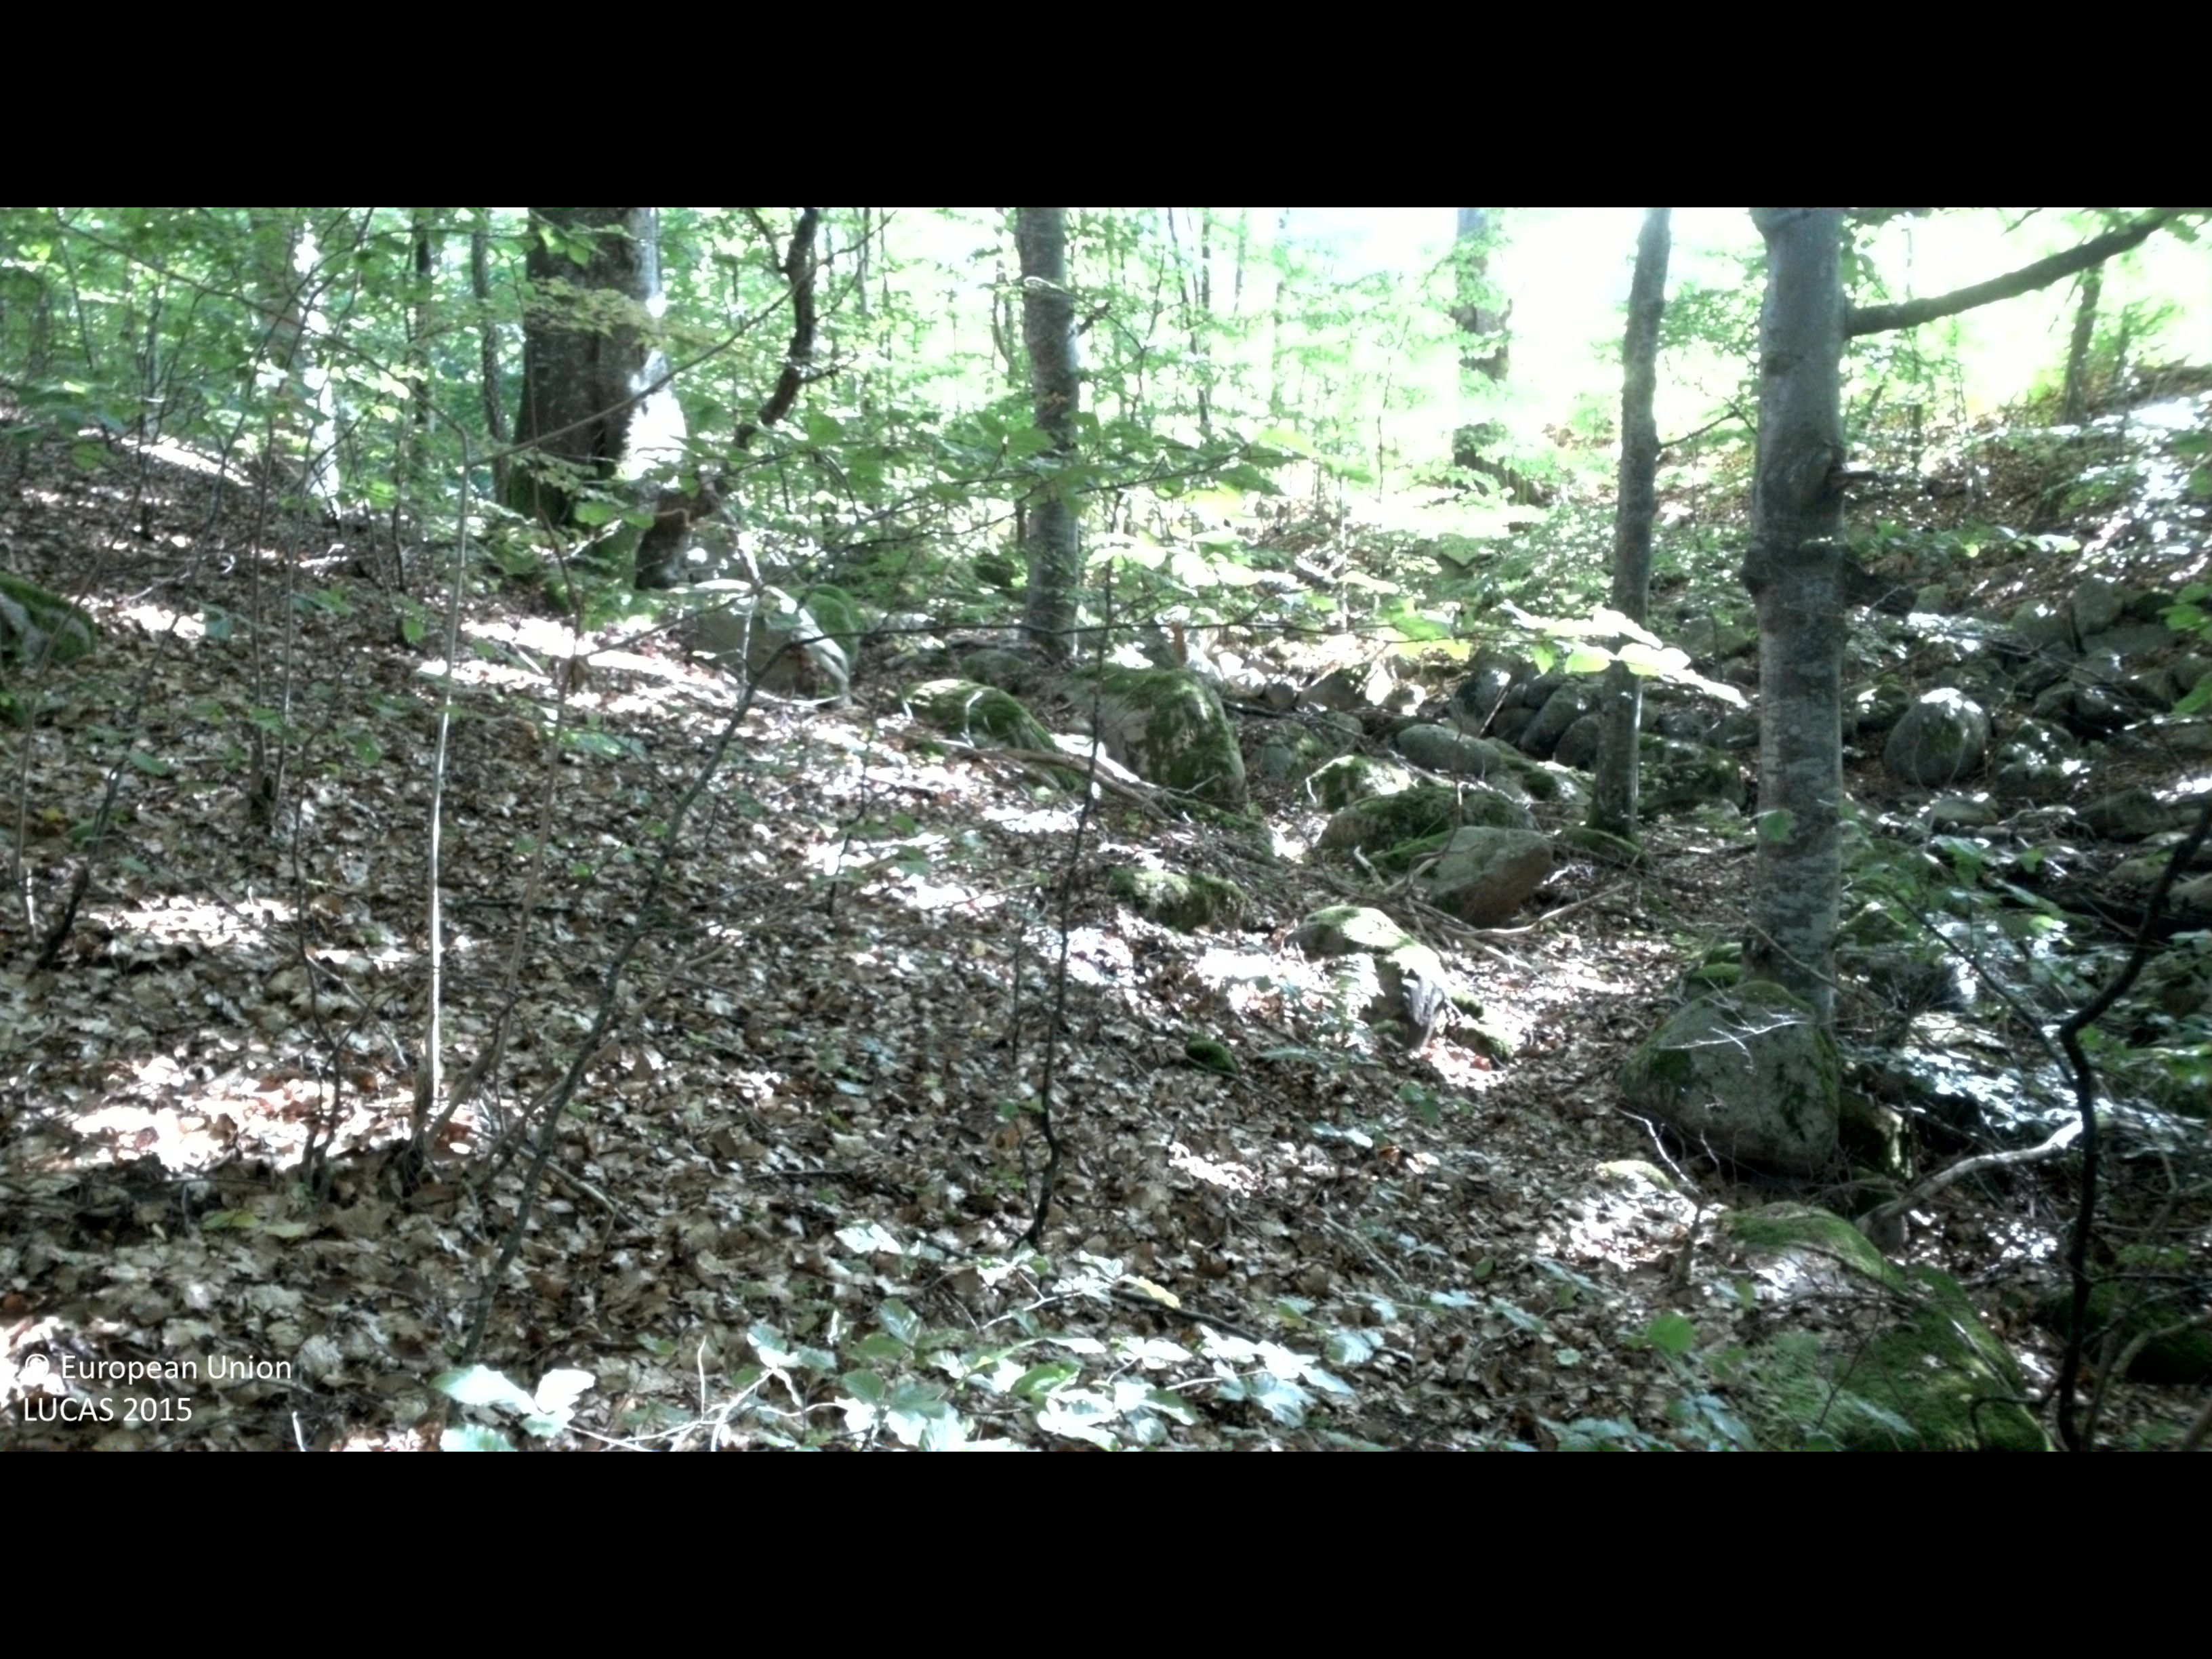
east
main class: Woodland
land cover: Broadleaved woodland
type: beech forest
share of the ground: > 75 %
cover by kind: broadleaved forest trees 90 %
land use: Forestry
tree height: > 5 m
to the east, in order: Broadleaved woodland; Rivers and streams; Broadleaved woodland; Dry stone walls; Broadleaved woodland; Paved roads, cycling and walking lanes; Broadleaved woodland; Tracks; Spruce dominated coniferous woodland; Tracks; Spruce dominated coniferous woodland; Broadleaved woodland; Dry stone walls; Spruce dominated coniferous woodland
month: September
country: SE
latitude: 56.1688
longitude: 14.3301
